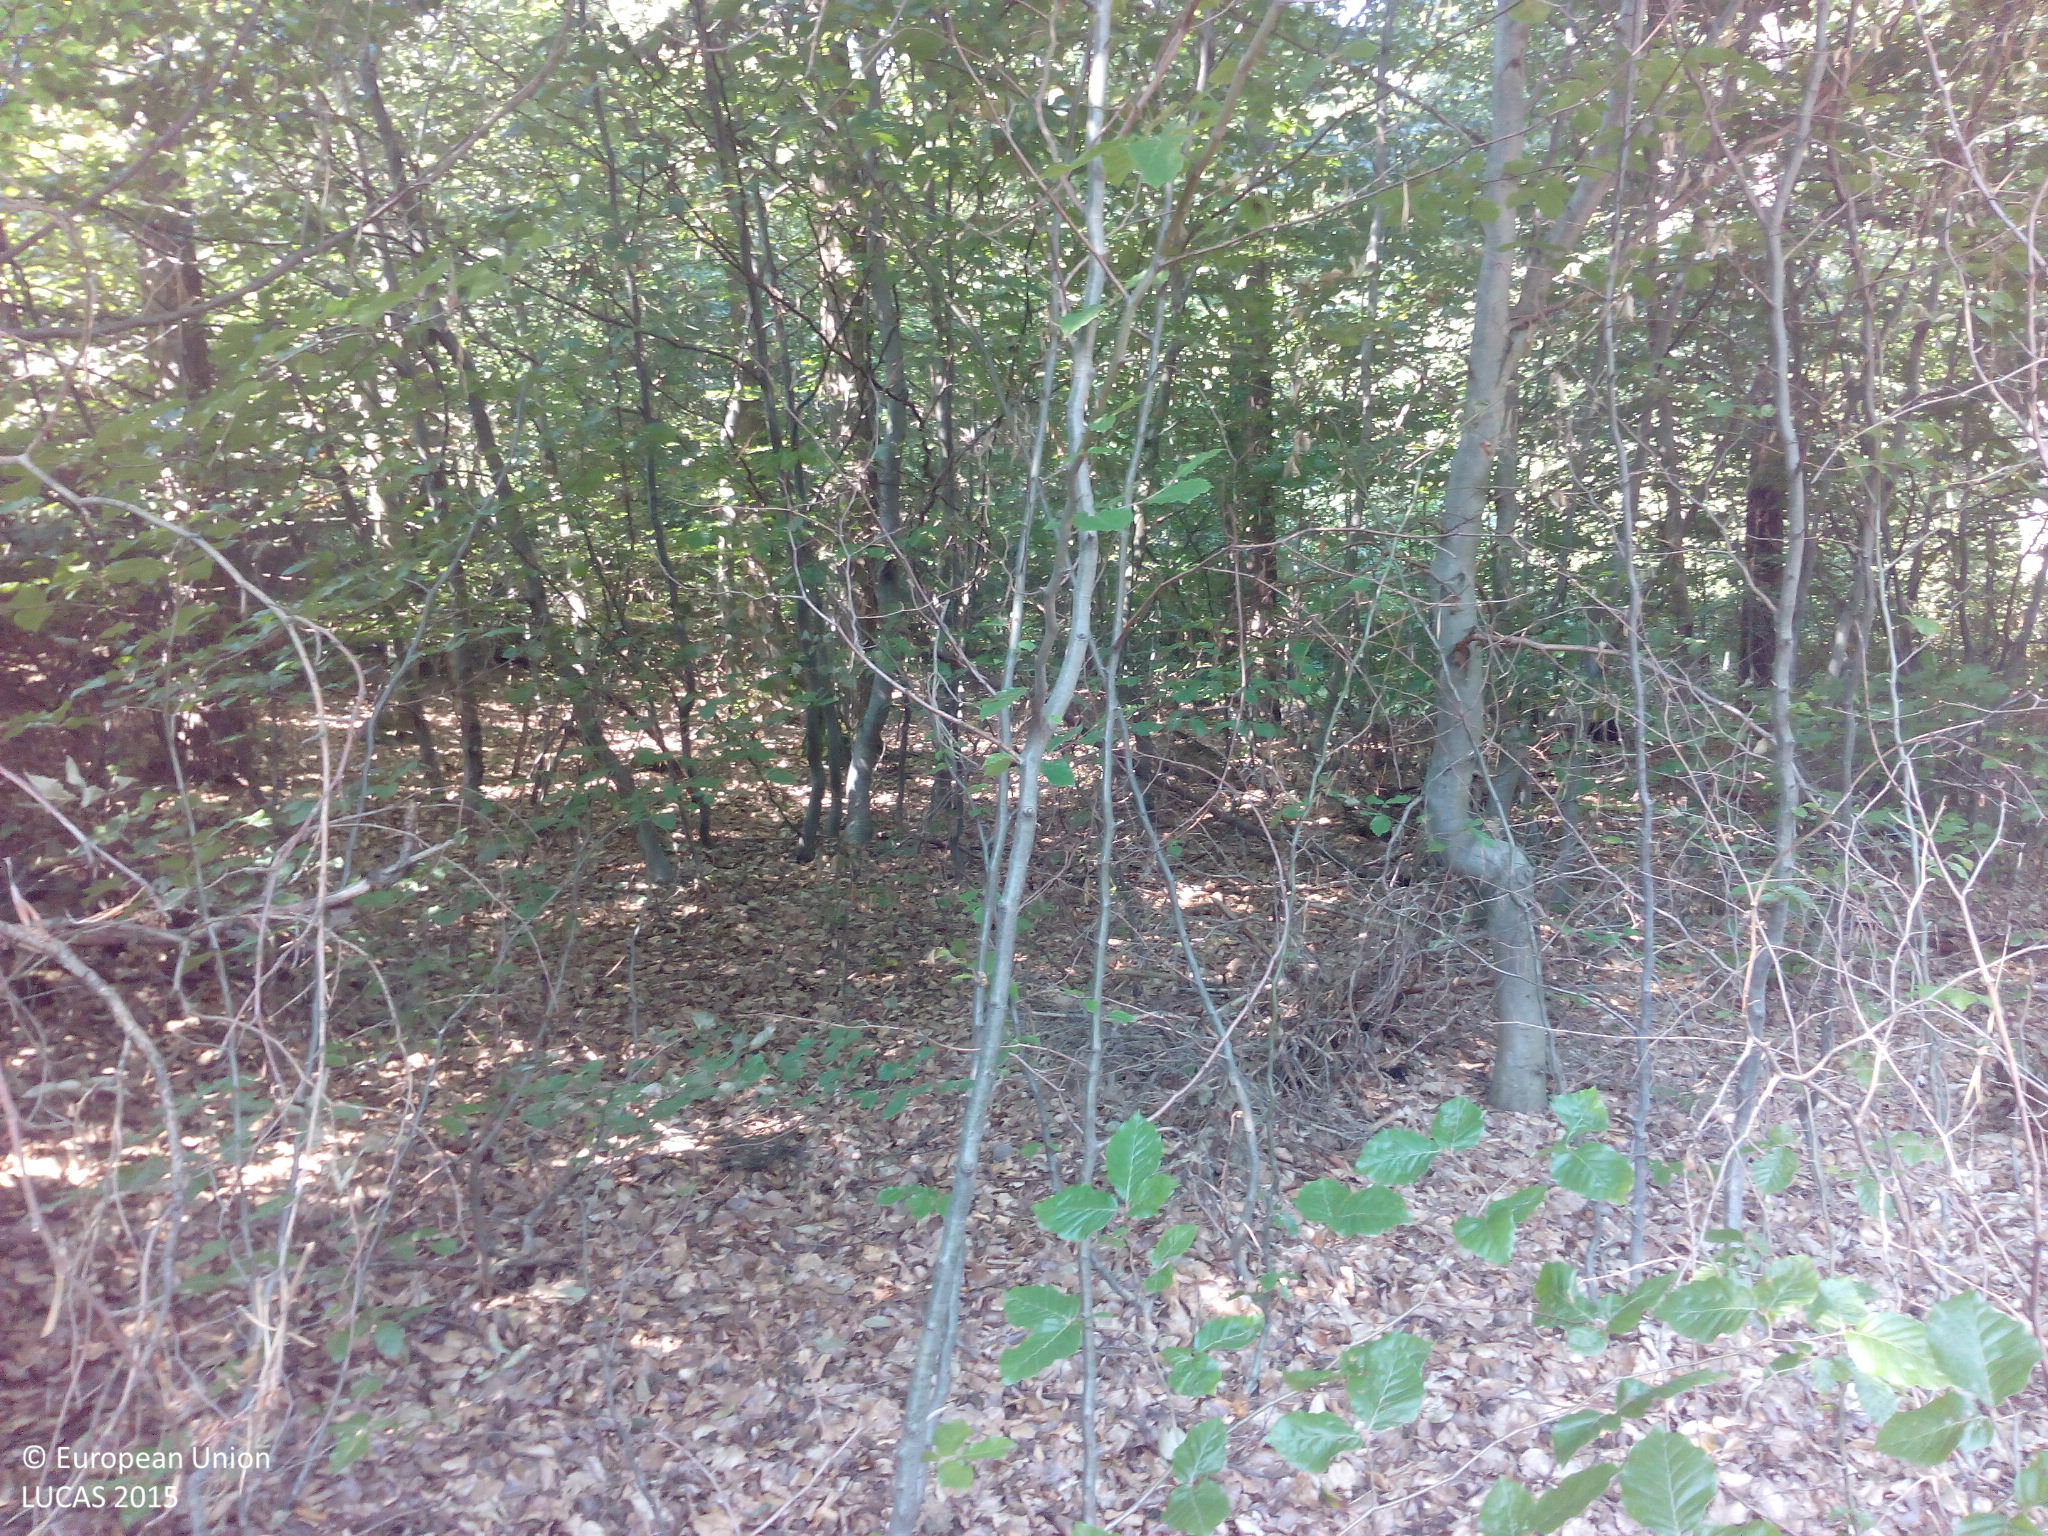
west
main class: Woodland
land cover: Broadleaved woodland
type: beech forest
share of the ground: > 75 %
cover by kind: broadleaved forest trees 90 %, consolidated bare surface 10 %
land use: Forestry
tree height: > 5 m
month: August
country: DE
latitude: 49.7614
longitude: 7.5154
